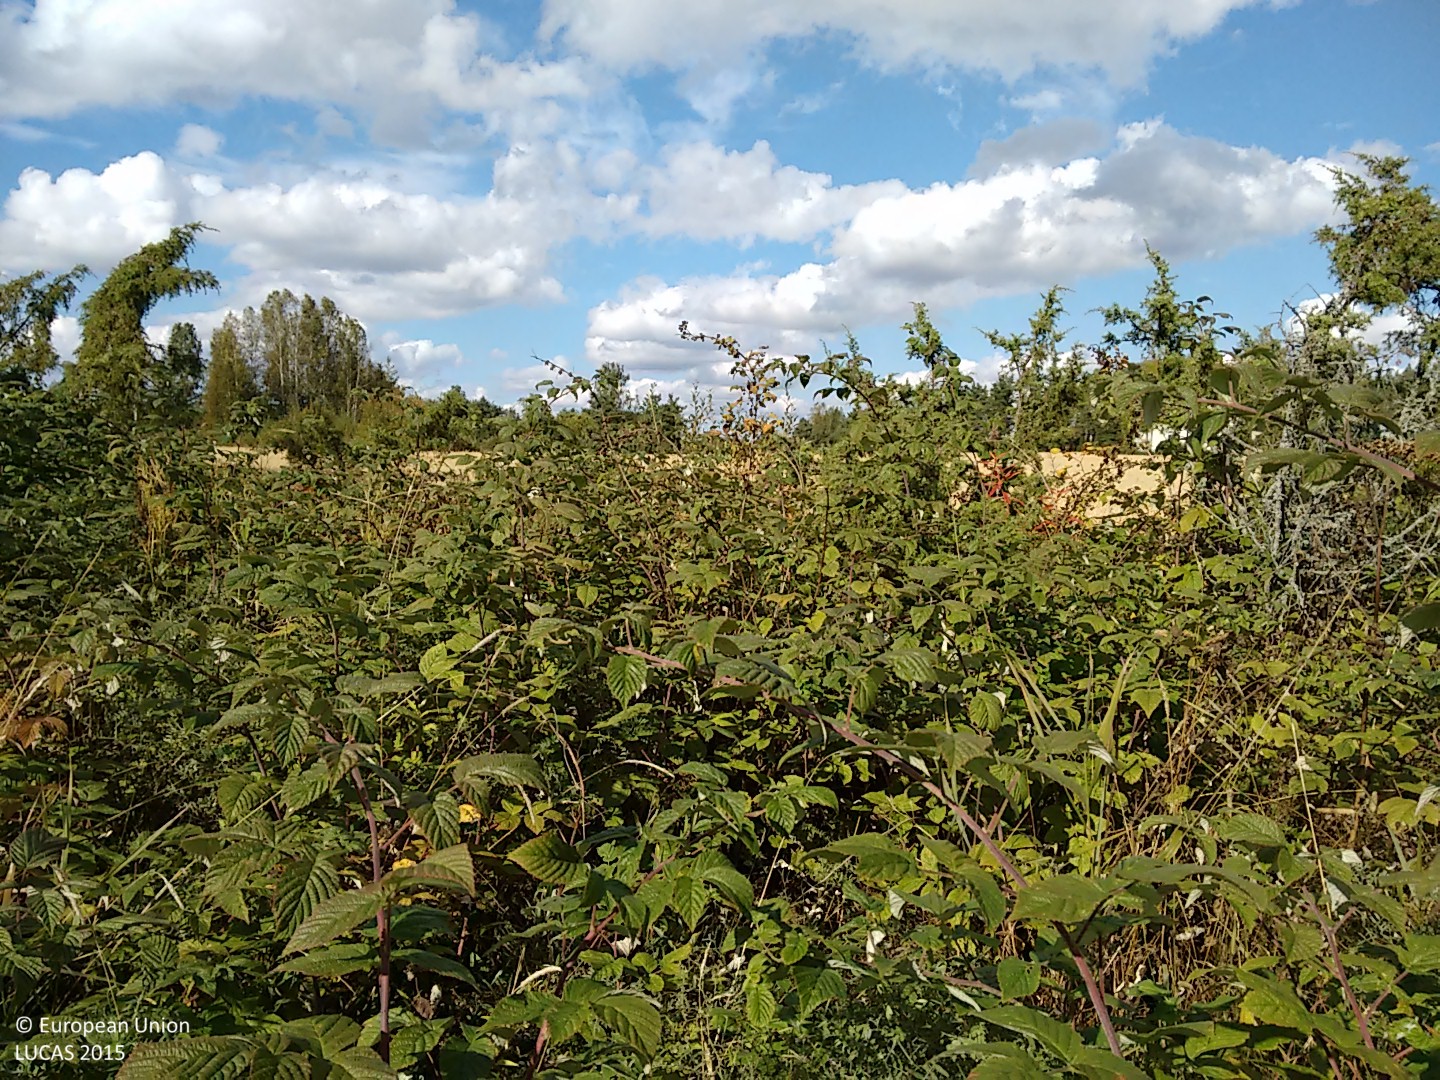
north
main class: Shrubland
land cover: Shrubland with sparse tree cover
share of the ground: > 75 %
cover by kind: shrubs 95 %, broadleaved forest trees 5 %
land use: Agriculture (excluding fallow land and kitchen gardens)
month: September
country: FI
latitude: 61.0234
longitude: 21.6952
